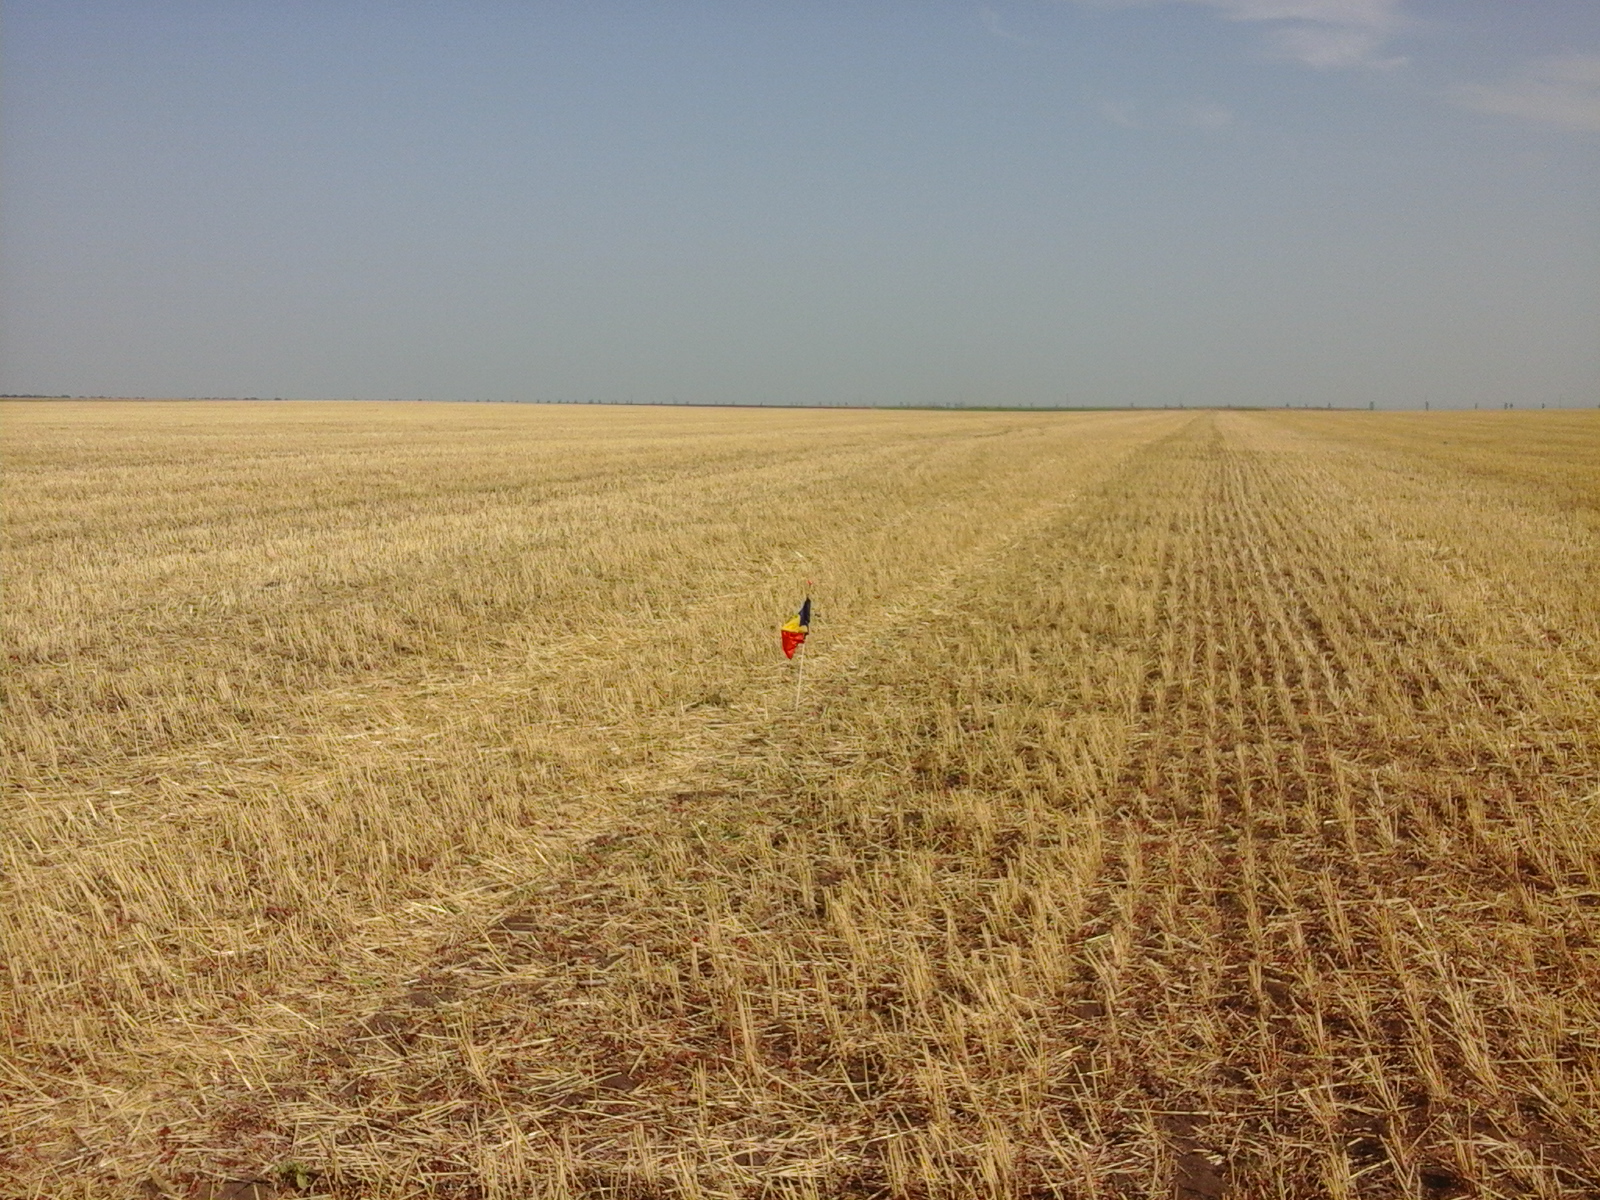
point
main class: Cropland
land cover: Common wheat
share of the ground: > 75 %
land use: Agriculture (excluding fallow land and kitchen gardens)
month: August
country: RO
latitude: 45.7817
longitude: 27.5868
